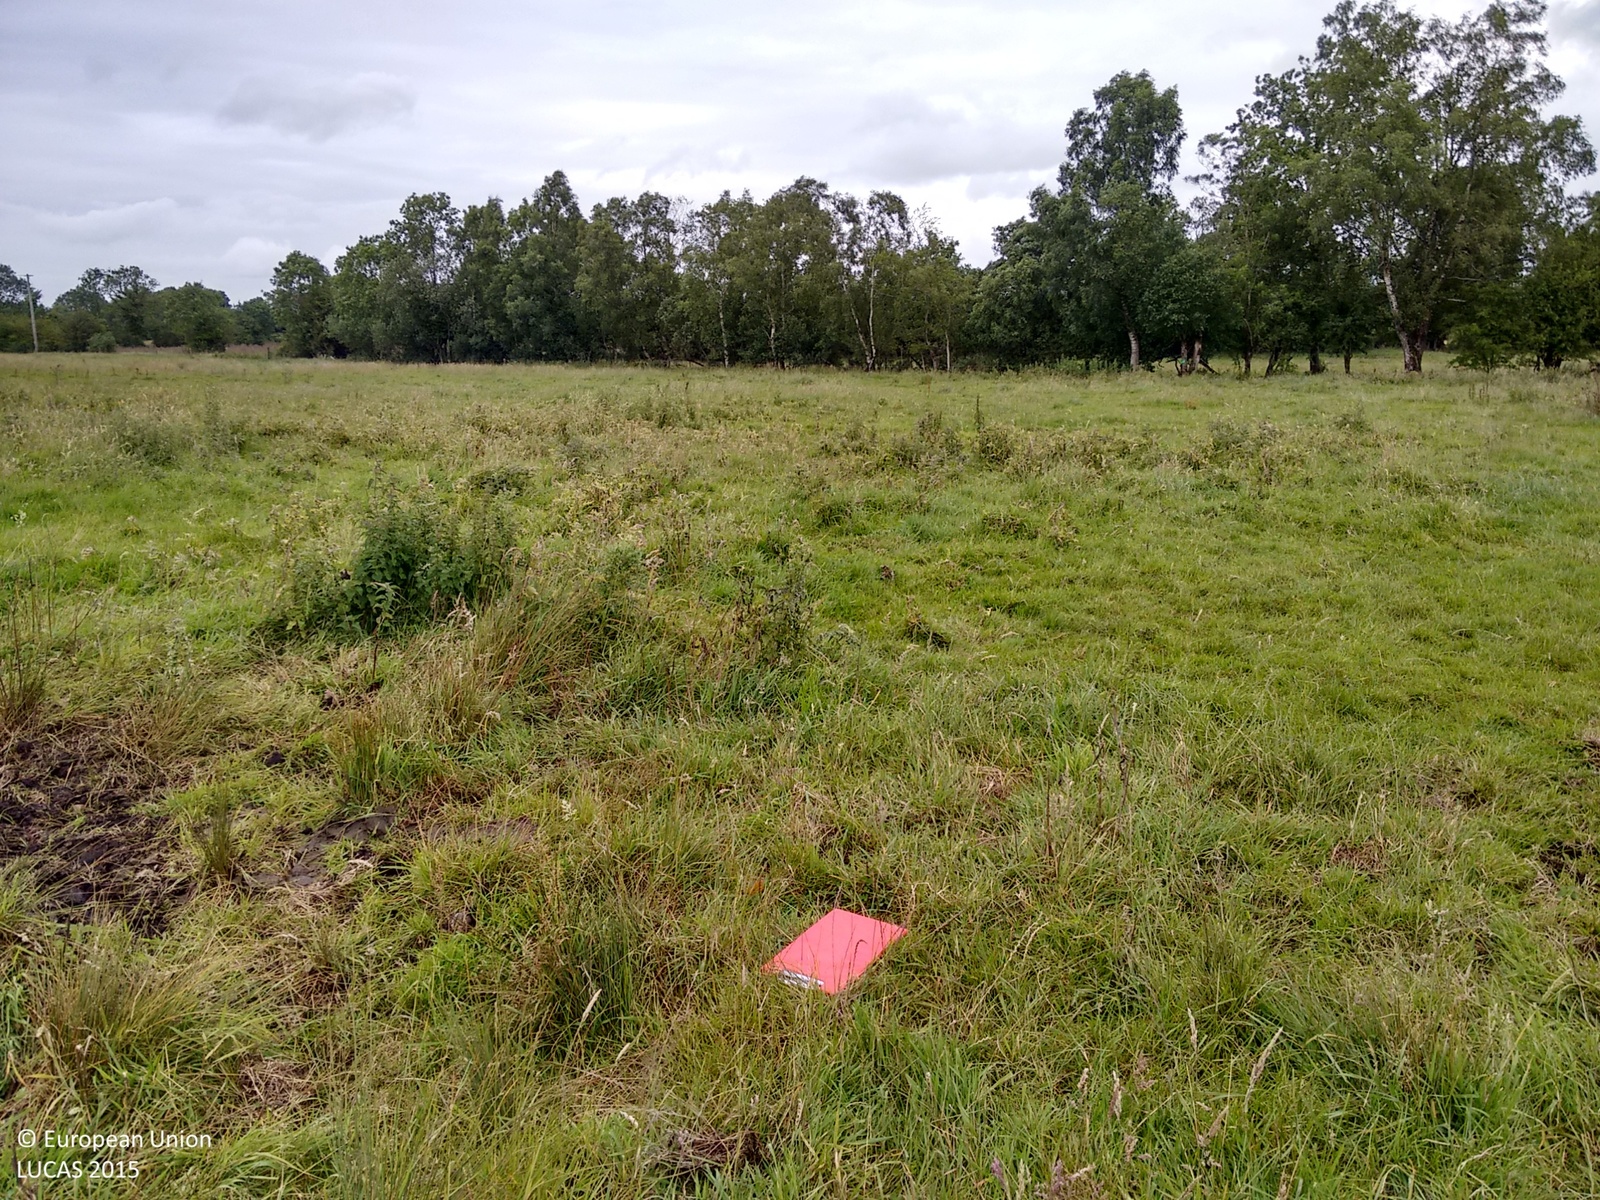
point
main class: Grassland
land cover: Grassland without tree/shrub cover
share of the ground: > 75 %
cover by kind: herbaceous plants 100 %
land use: Agriculture (excluding fallow land and kitchen gardens)
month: July
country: IE
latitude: 53.6325
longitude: -7.8167
